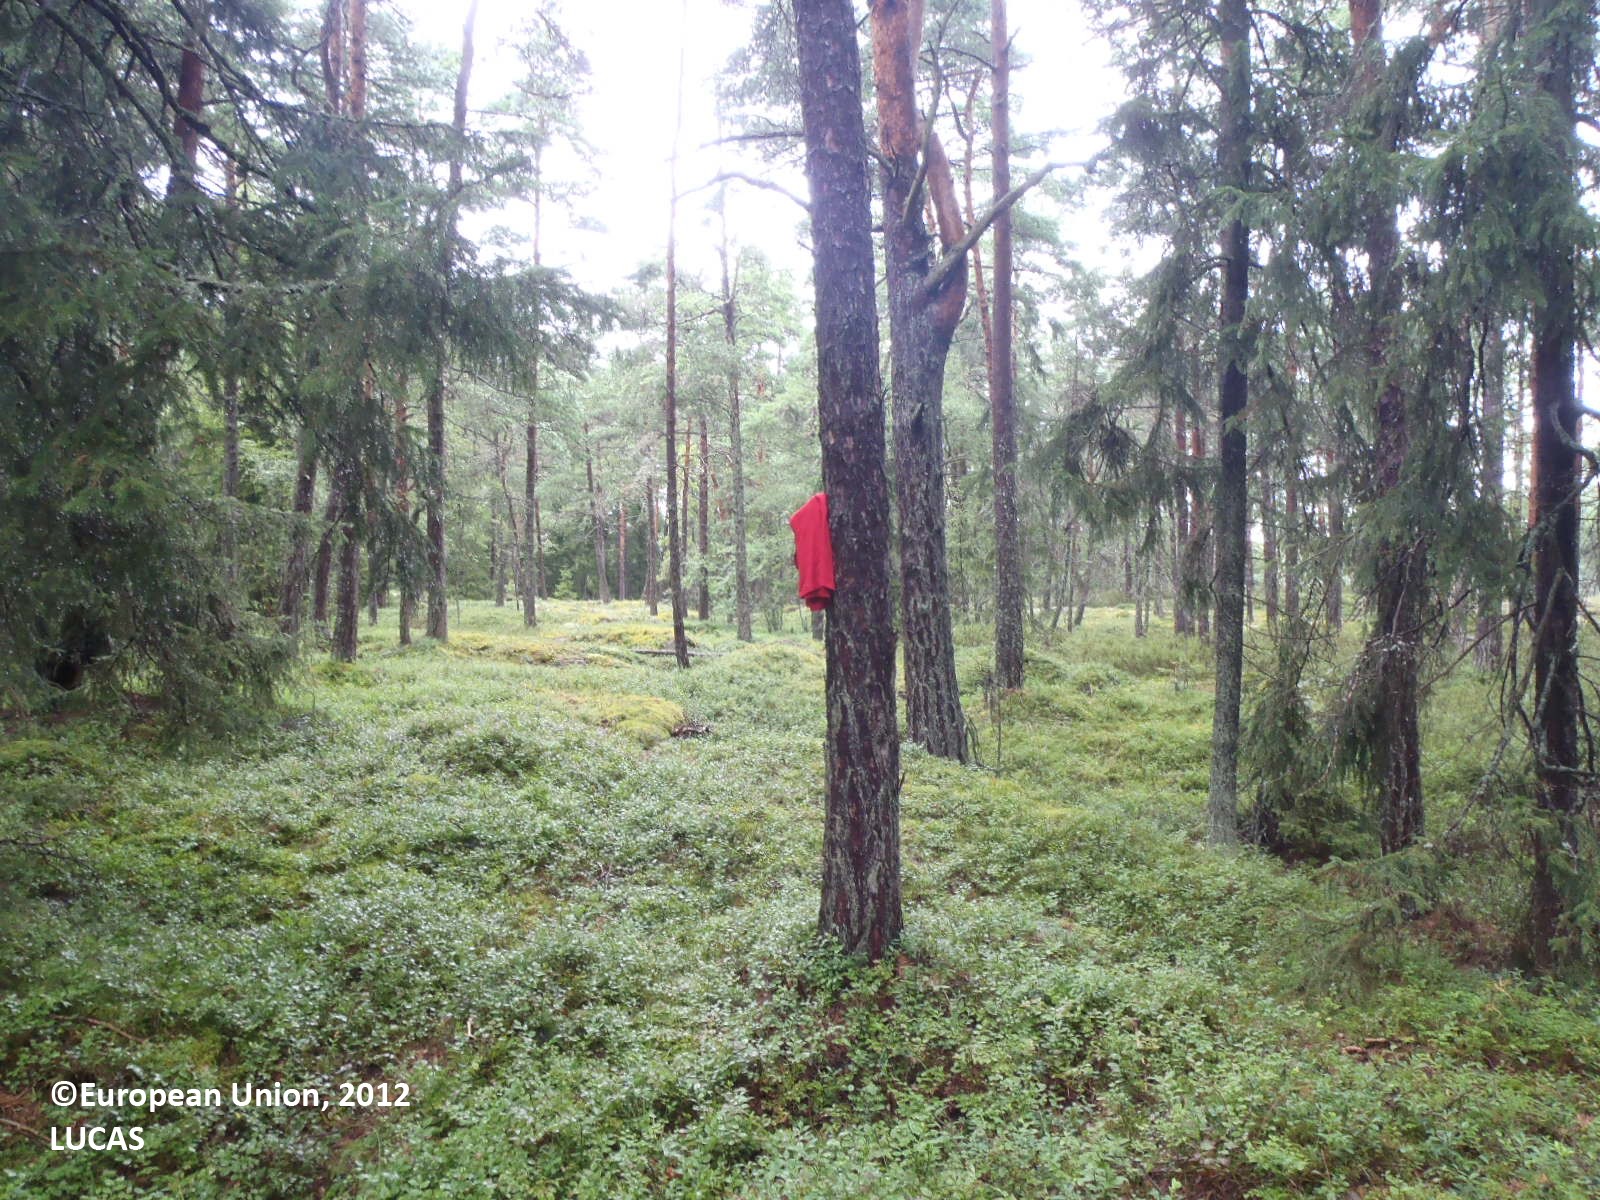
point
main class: Woodland
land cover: Pine dominated coniferous woodland
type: boreal forest
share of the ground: 50 - 75 %
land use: Forestry
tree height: > 5 m
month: August
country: FI
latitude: 60.1157
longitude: 19.9934
